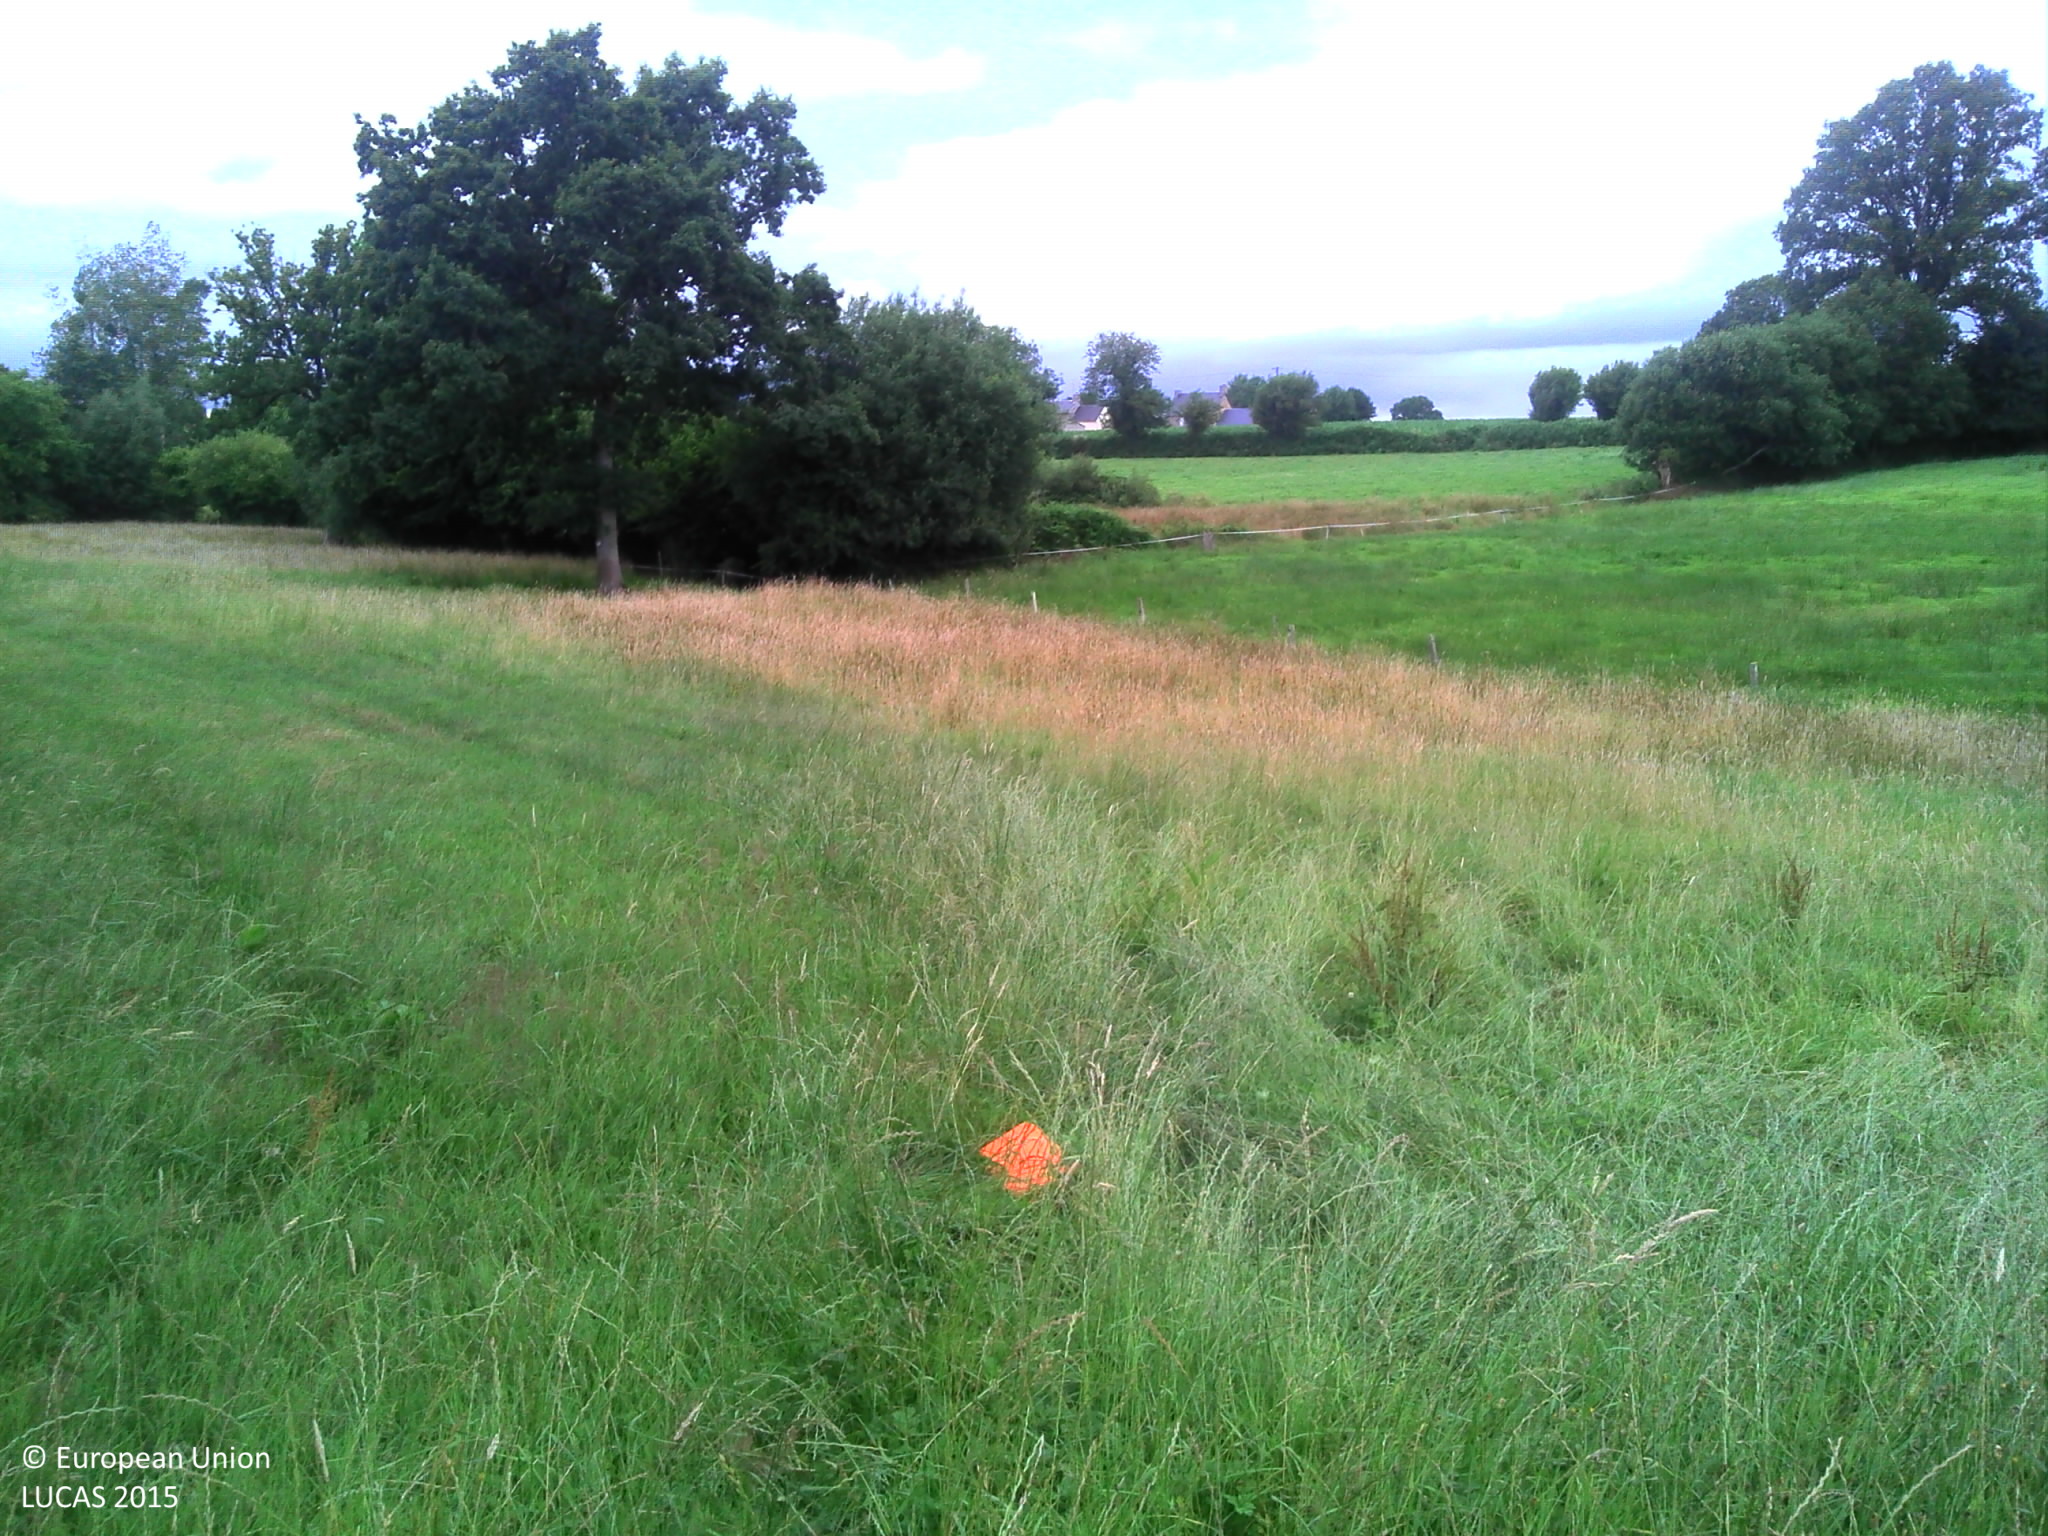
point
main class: Grassland
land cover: Grassland without tree/shrub cover
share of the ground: > 75 %
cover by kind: herbaceous plants 100 %
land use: Agriculture (excluding fallow land and kitchen gardens)
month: July
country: FR
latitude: 48.7849
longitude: -1.3009
